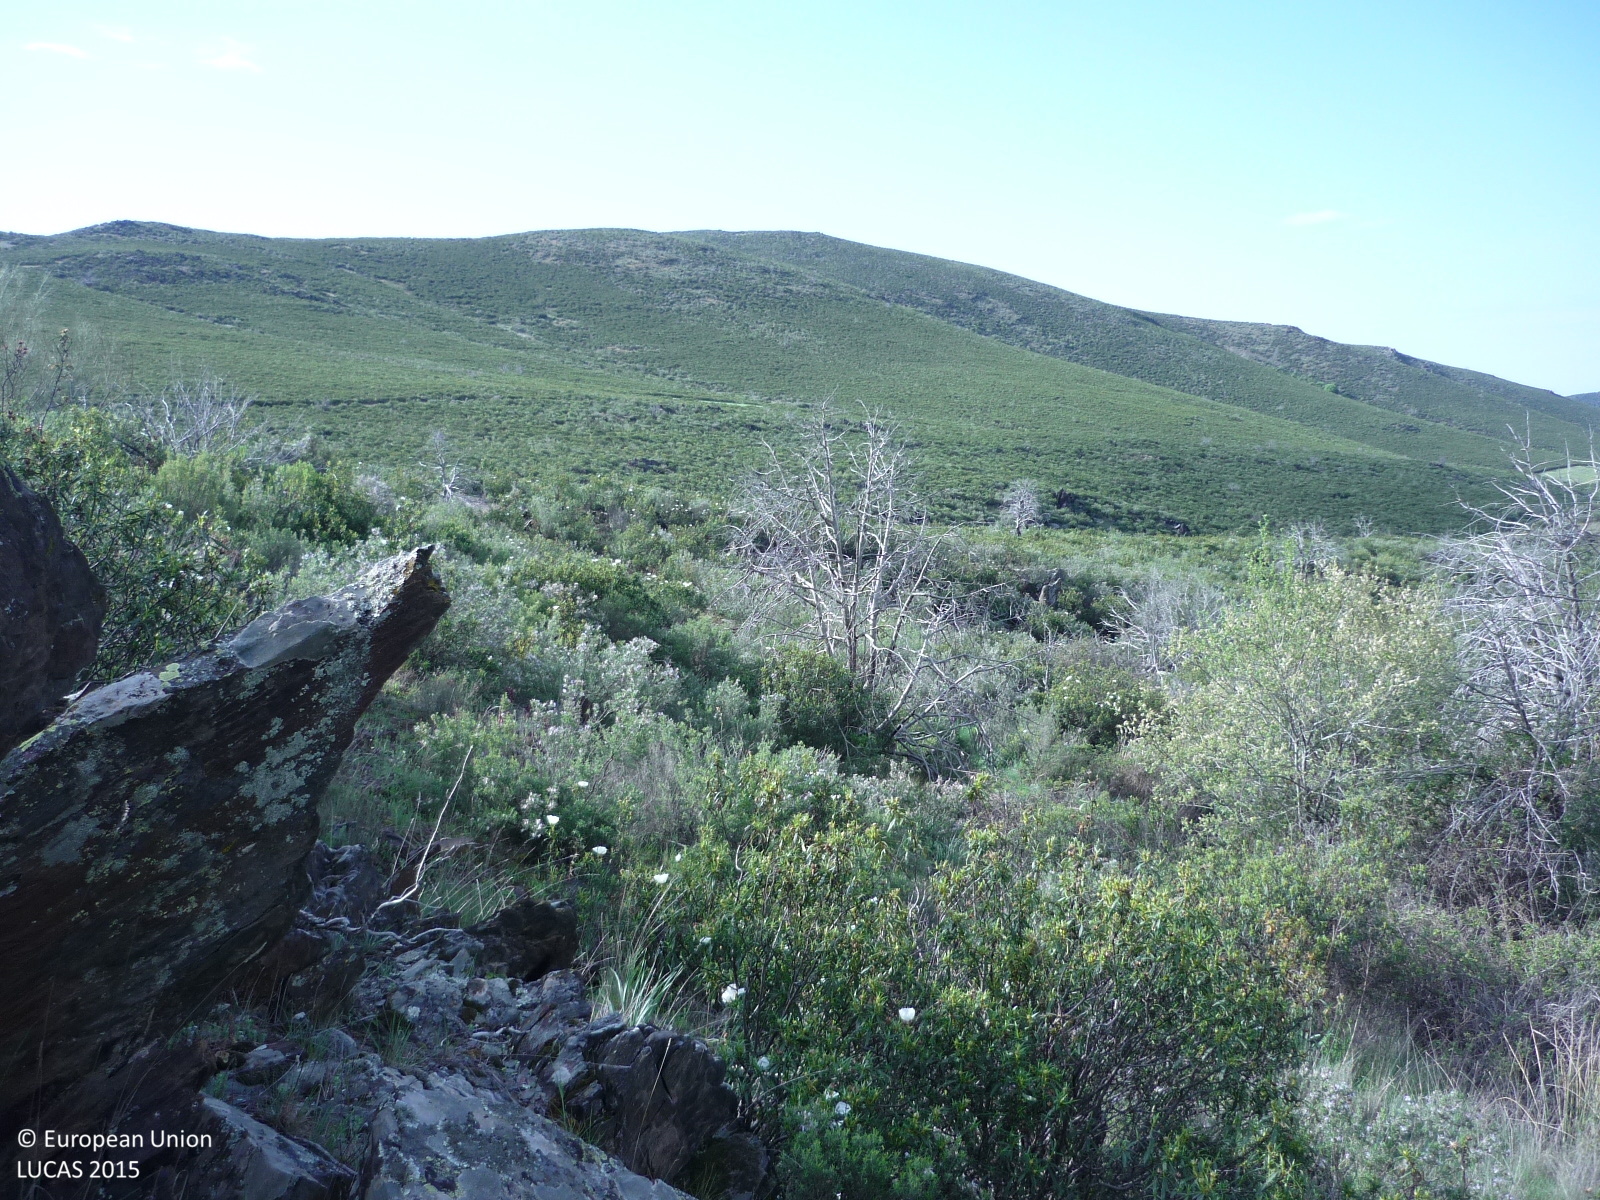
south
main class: Shrubland
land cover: Shrubland without tree cover
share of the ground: > 75 %
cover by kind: shrubs 90 %, herbaceous plants 10 %
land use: Semi-natural and natural areas not in use
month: April
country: ES
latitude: 40.8843
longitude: -3.5108
